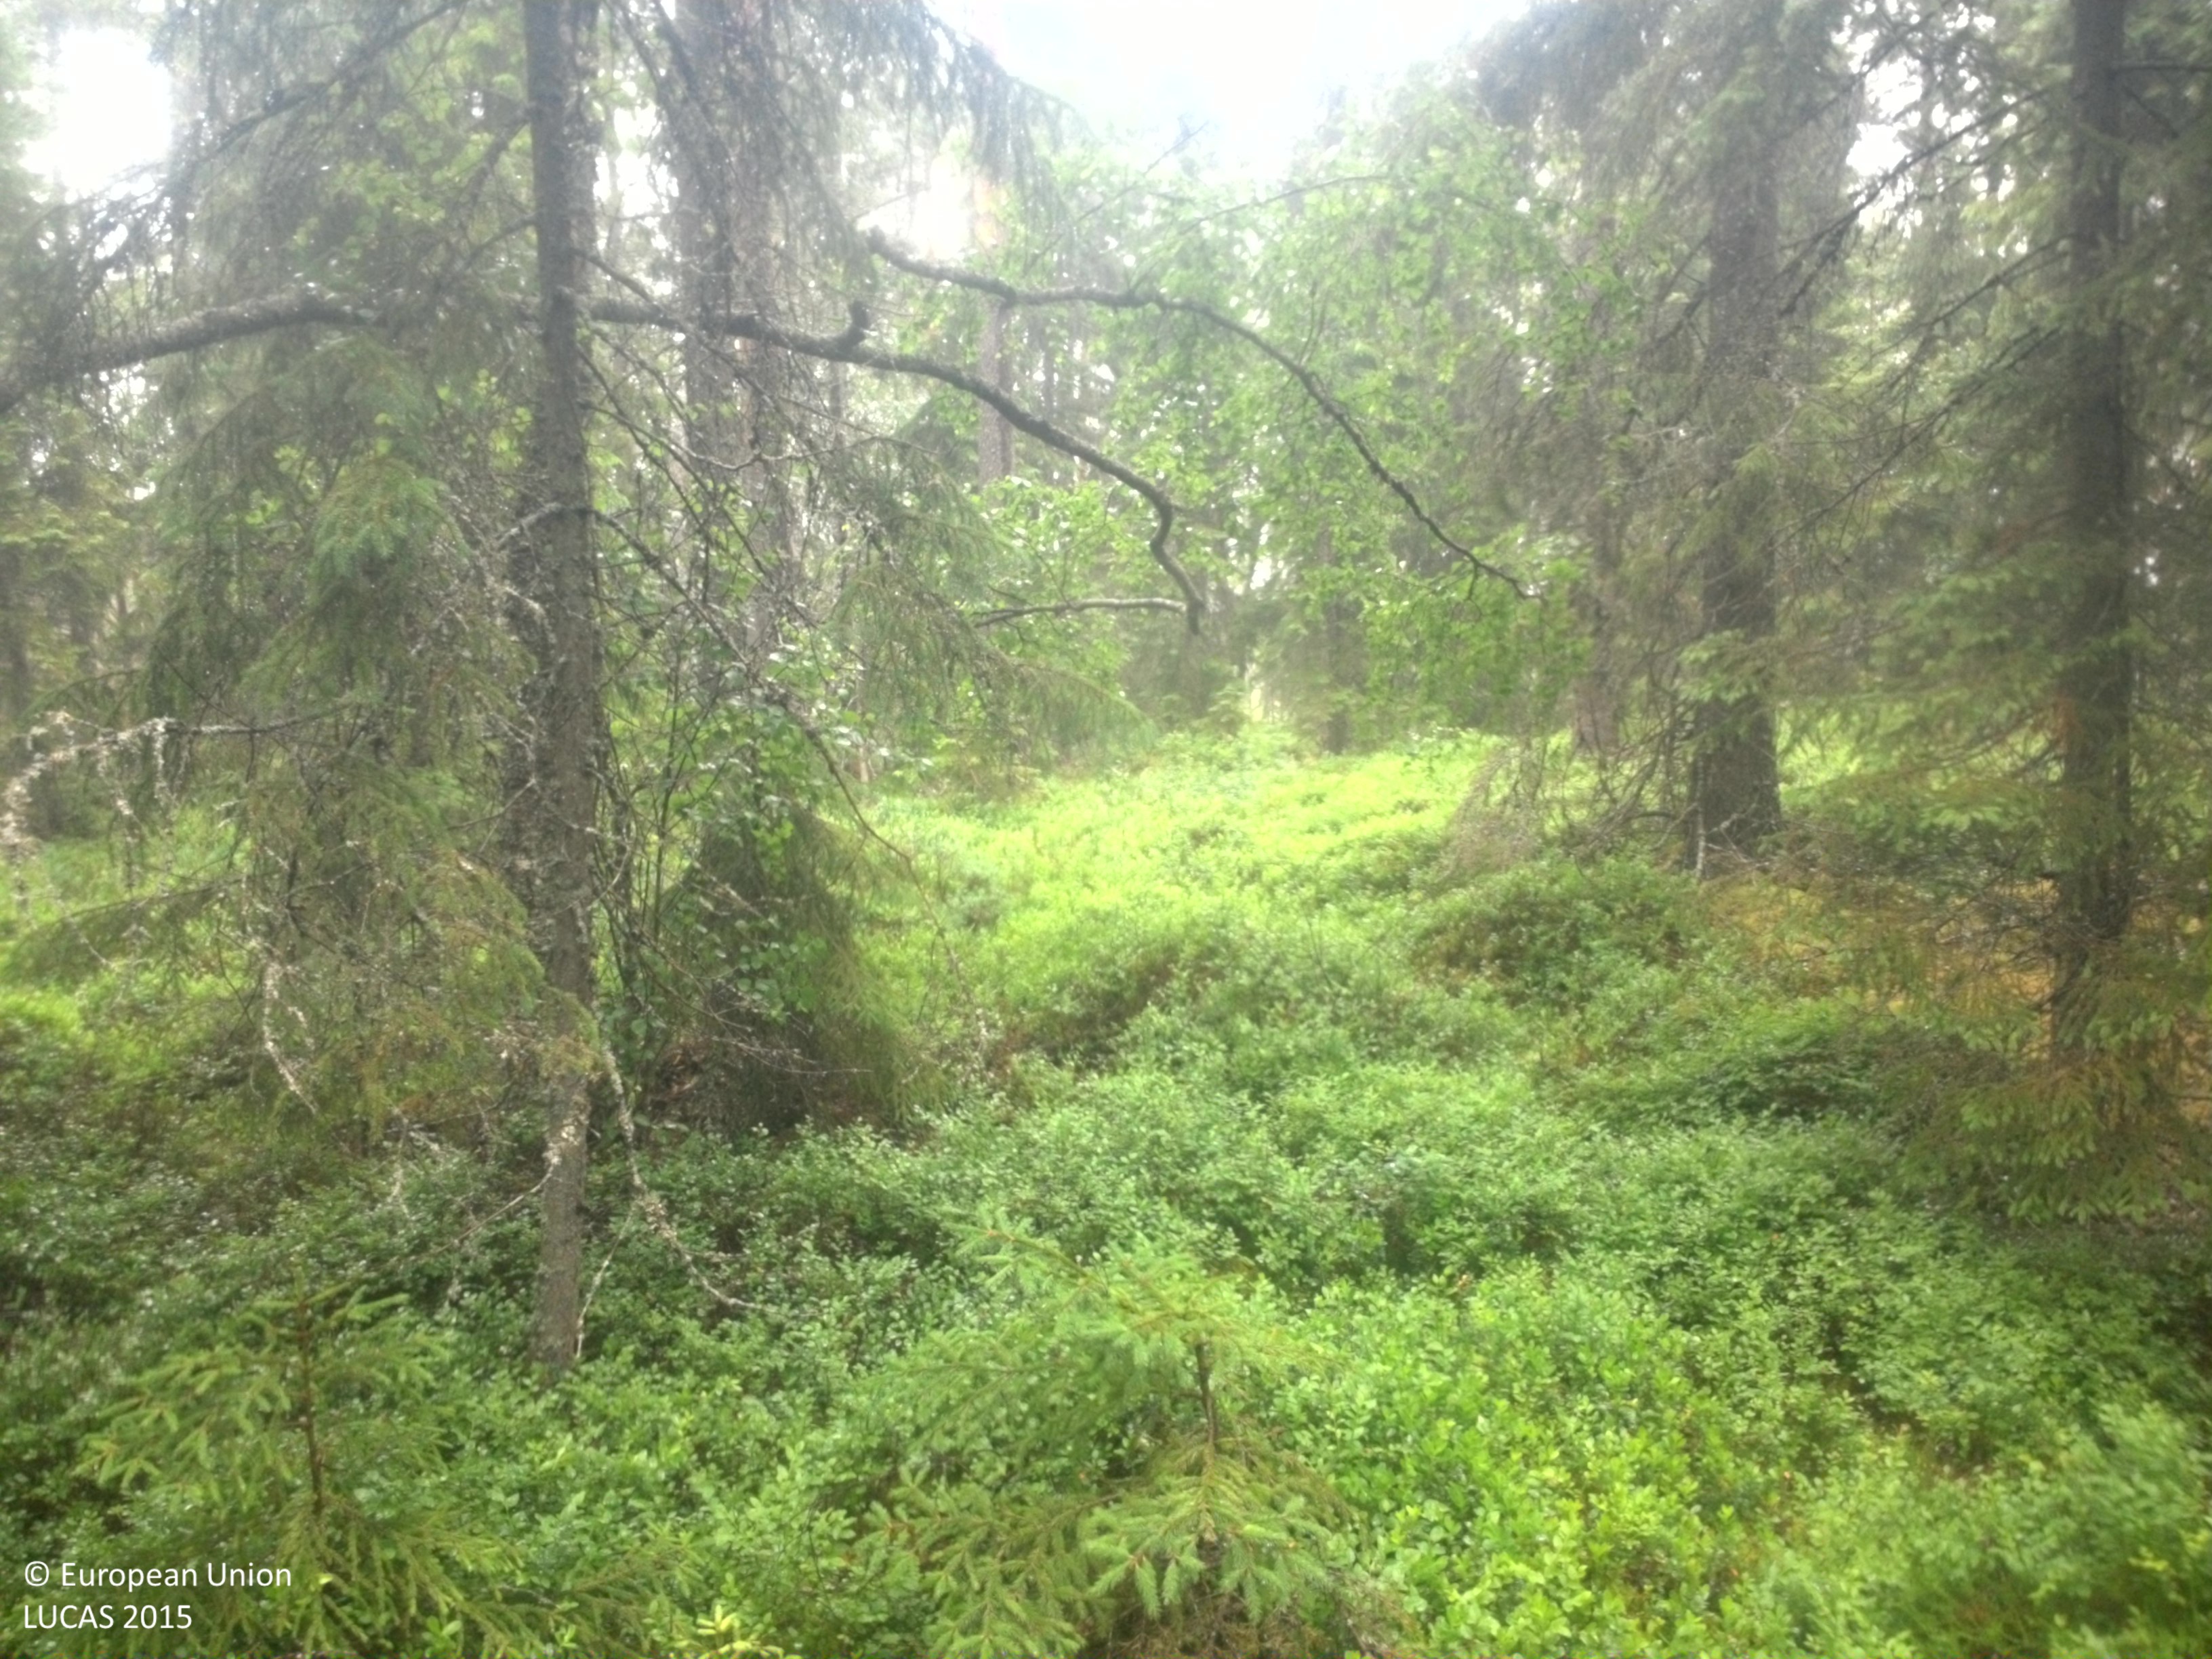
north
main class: Woodland
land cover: Other mixed woodland
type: boreal forest
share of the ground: 50 - 75 %
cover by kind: shrubs 40 %, coniferous forest trees 30 %, broadleaved forest trees 20 %, herbaceous plants 10 %
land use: Forestry
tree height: > 5 m
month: July
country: SE
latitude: 59.3814
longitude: 14.6911
